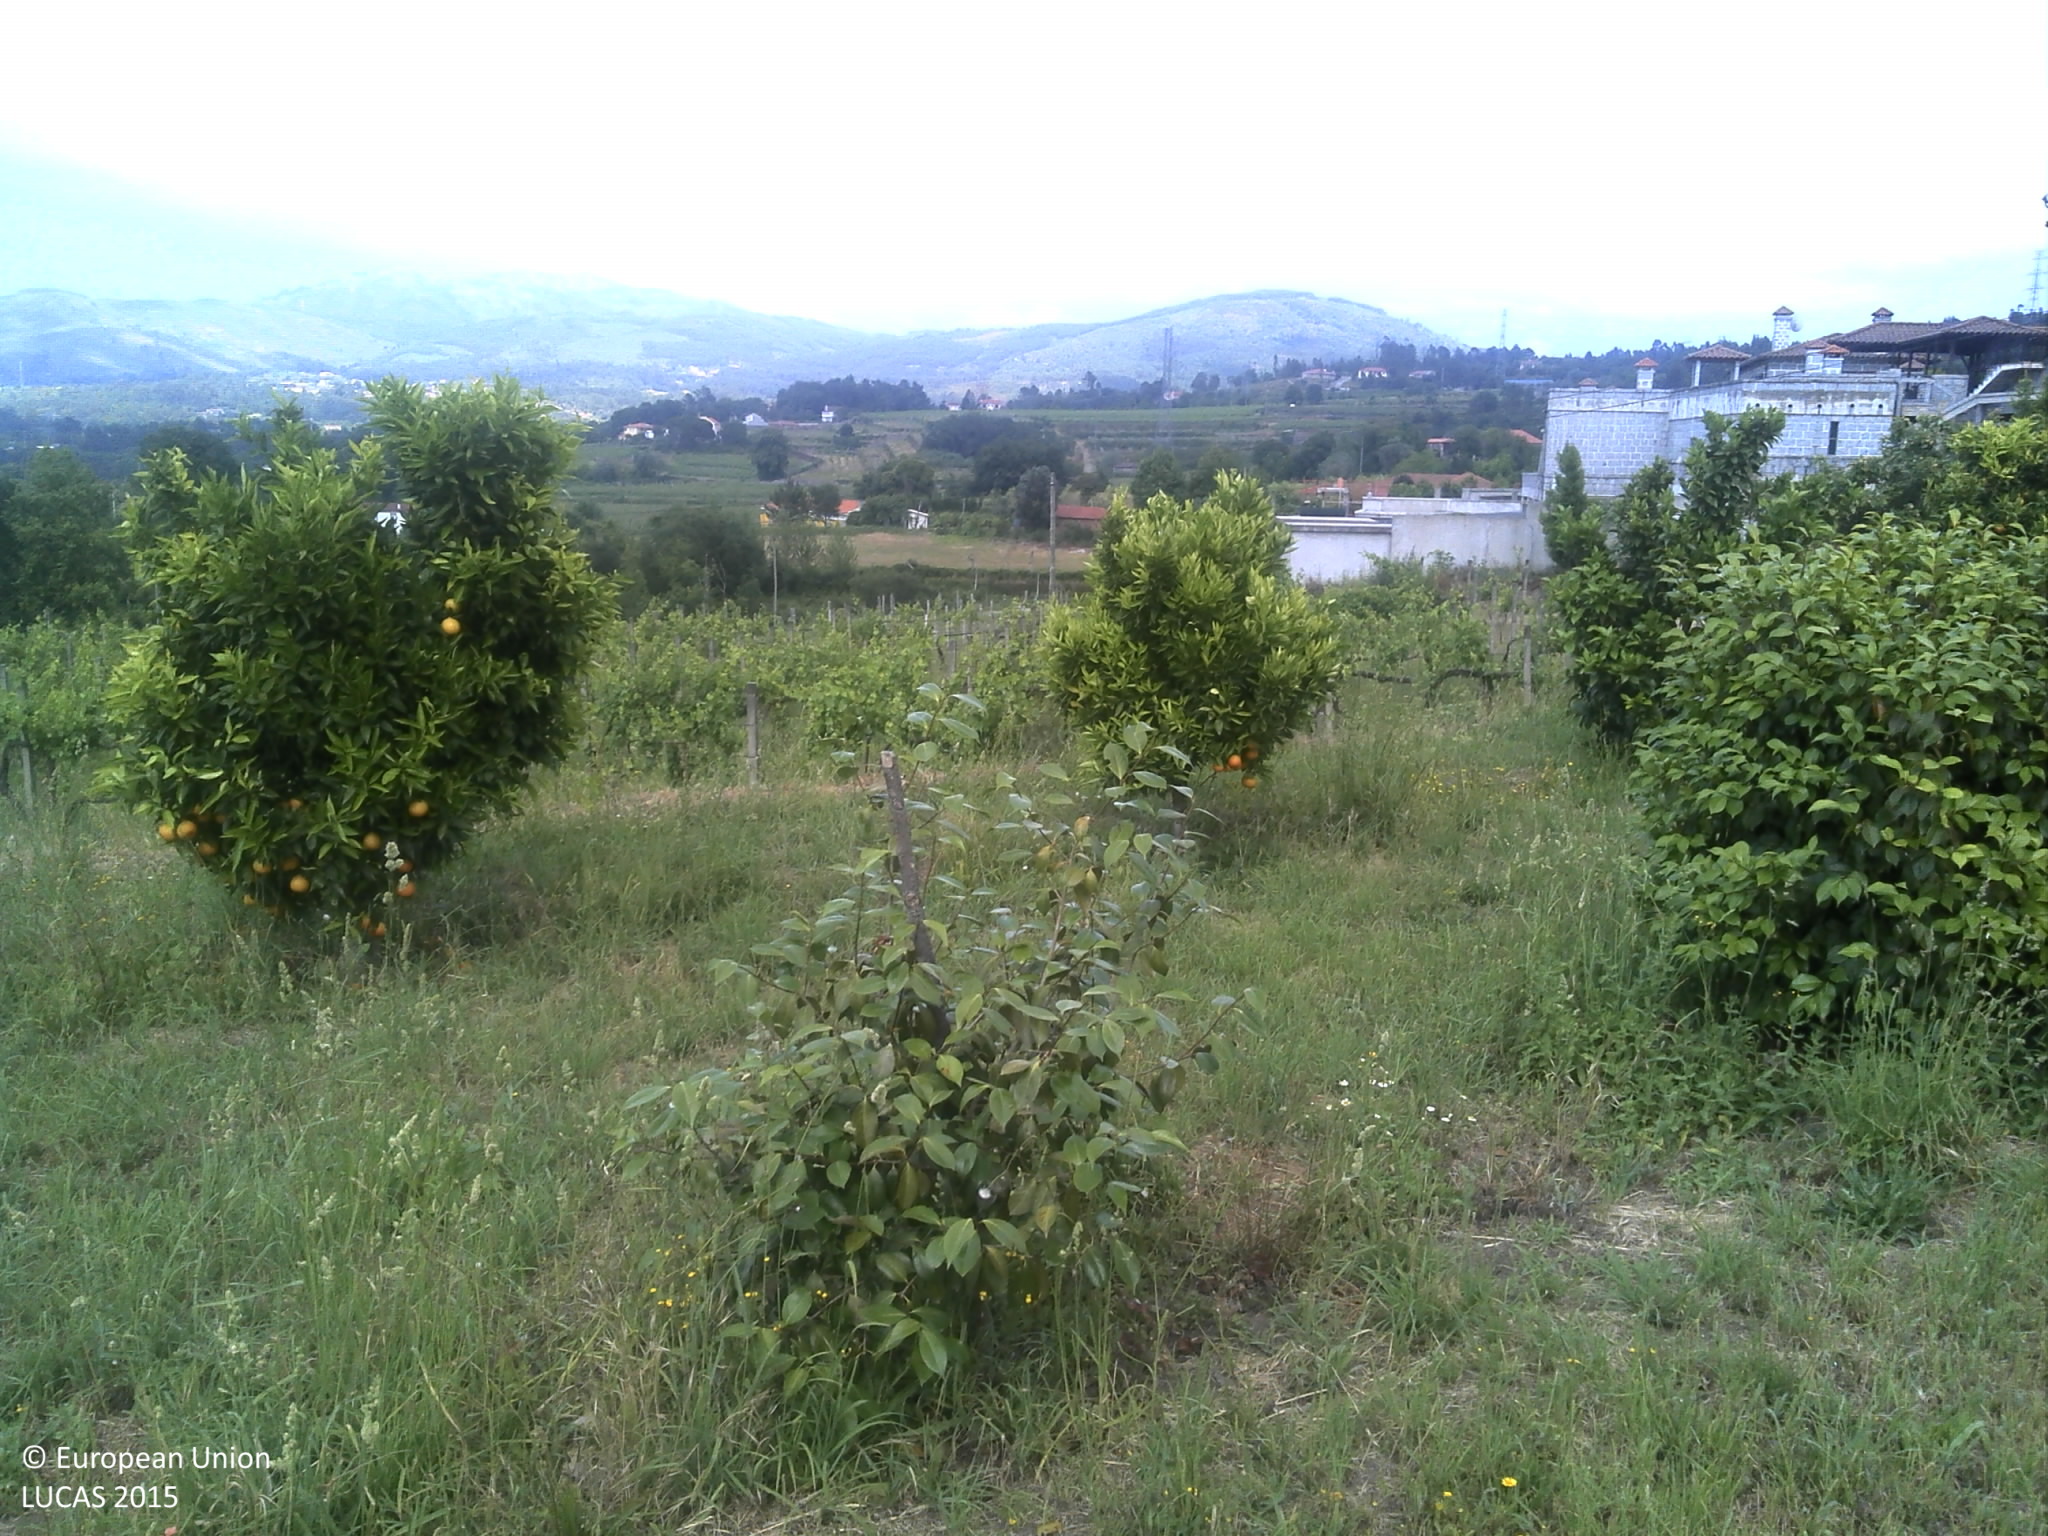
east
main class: Grassland
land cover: Grassland with sparse tree/shrub cover
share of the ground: 50 - 75 %
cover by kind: herbaceous plants 70 %, unconsolidated bare surface 20 %, broadleaved forest trees 5 %, shrubs 5 %
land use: Agriculture (excluding fallow land and kitchen gardens)
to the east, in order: Grassland with sparse tree/shrub cover; Grassland without tree/shrub cover; Vineyards; Electric lines; Maize; Vineyards; Rivers and streams; Abandoned hedges; Arable land (only in case pi); Abandoned hedges; Arable land (only in case pi); Fences; Single bushes/trees; Arable land (only in case pi)
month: June
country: PT
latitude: 41.6104
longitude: -8.3319
